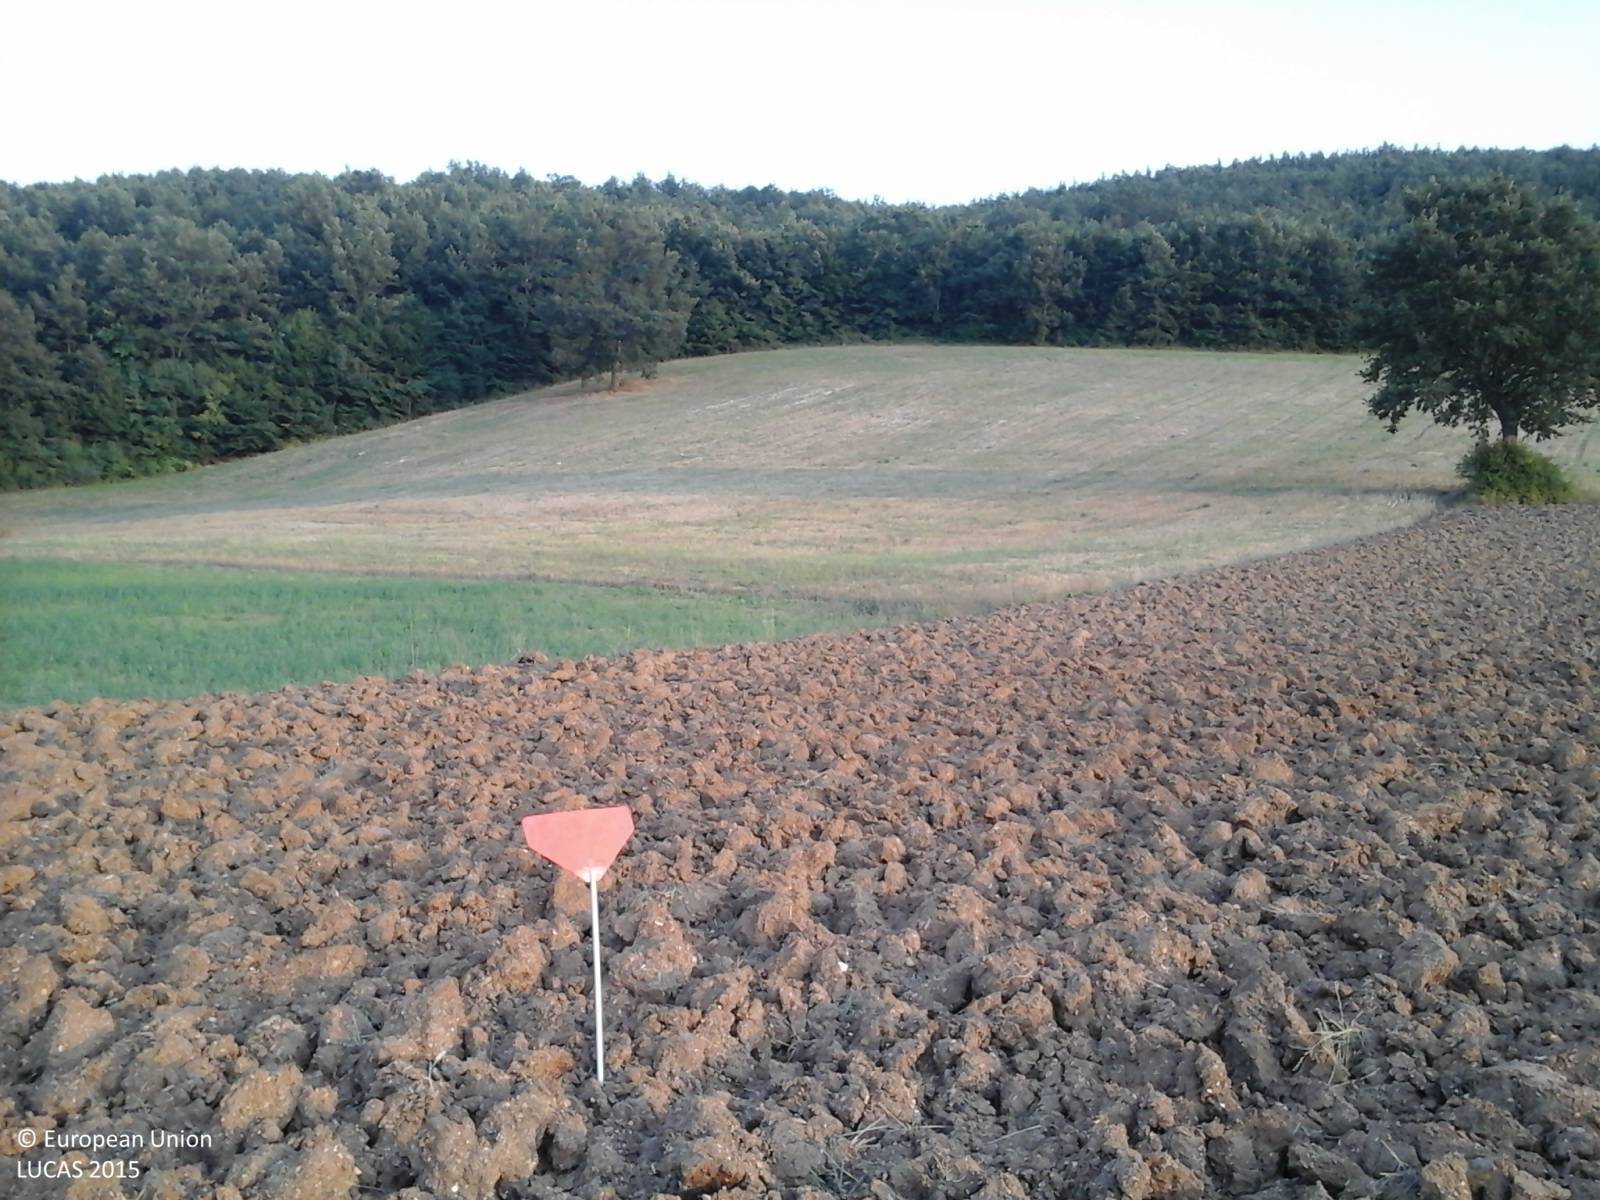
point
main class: Cropland
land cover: Durum wheat
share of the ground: < 10 %
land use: Agriculture (excluding fallow land and kitchen gardens)
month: August
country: IT
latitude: 43.0295
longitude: 12.8513
